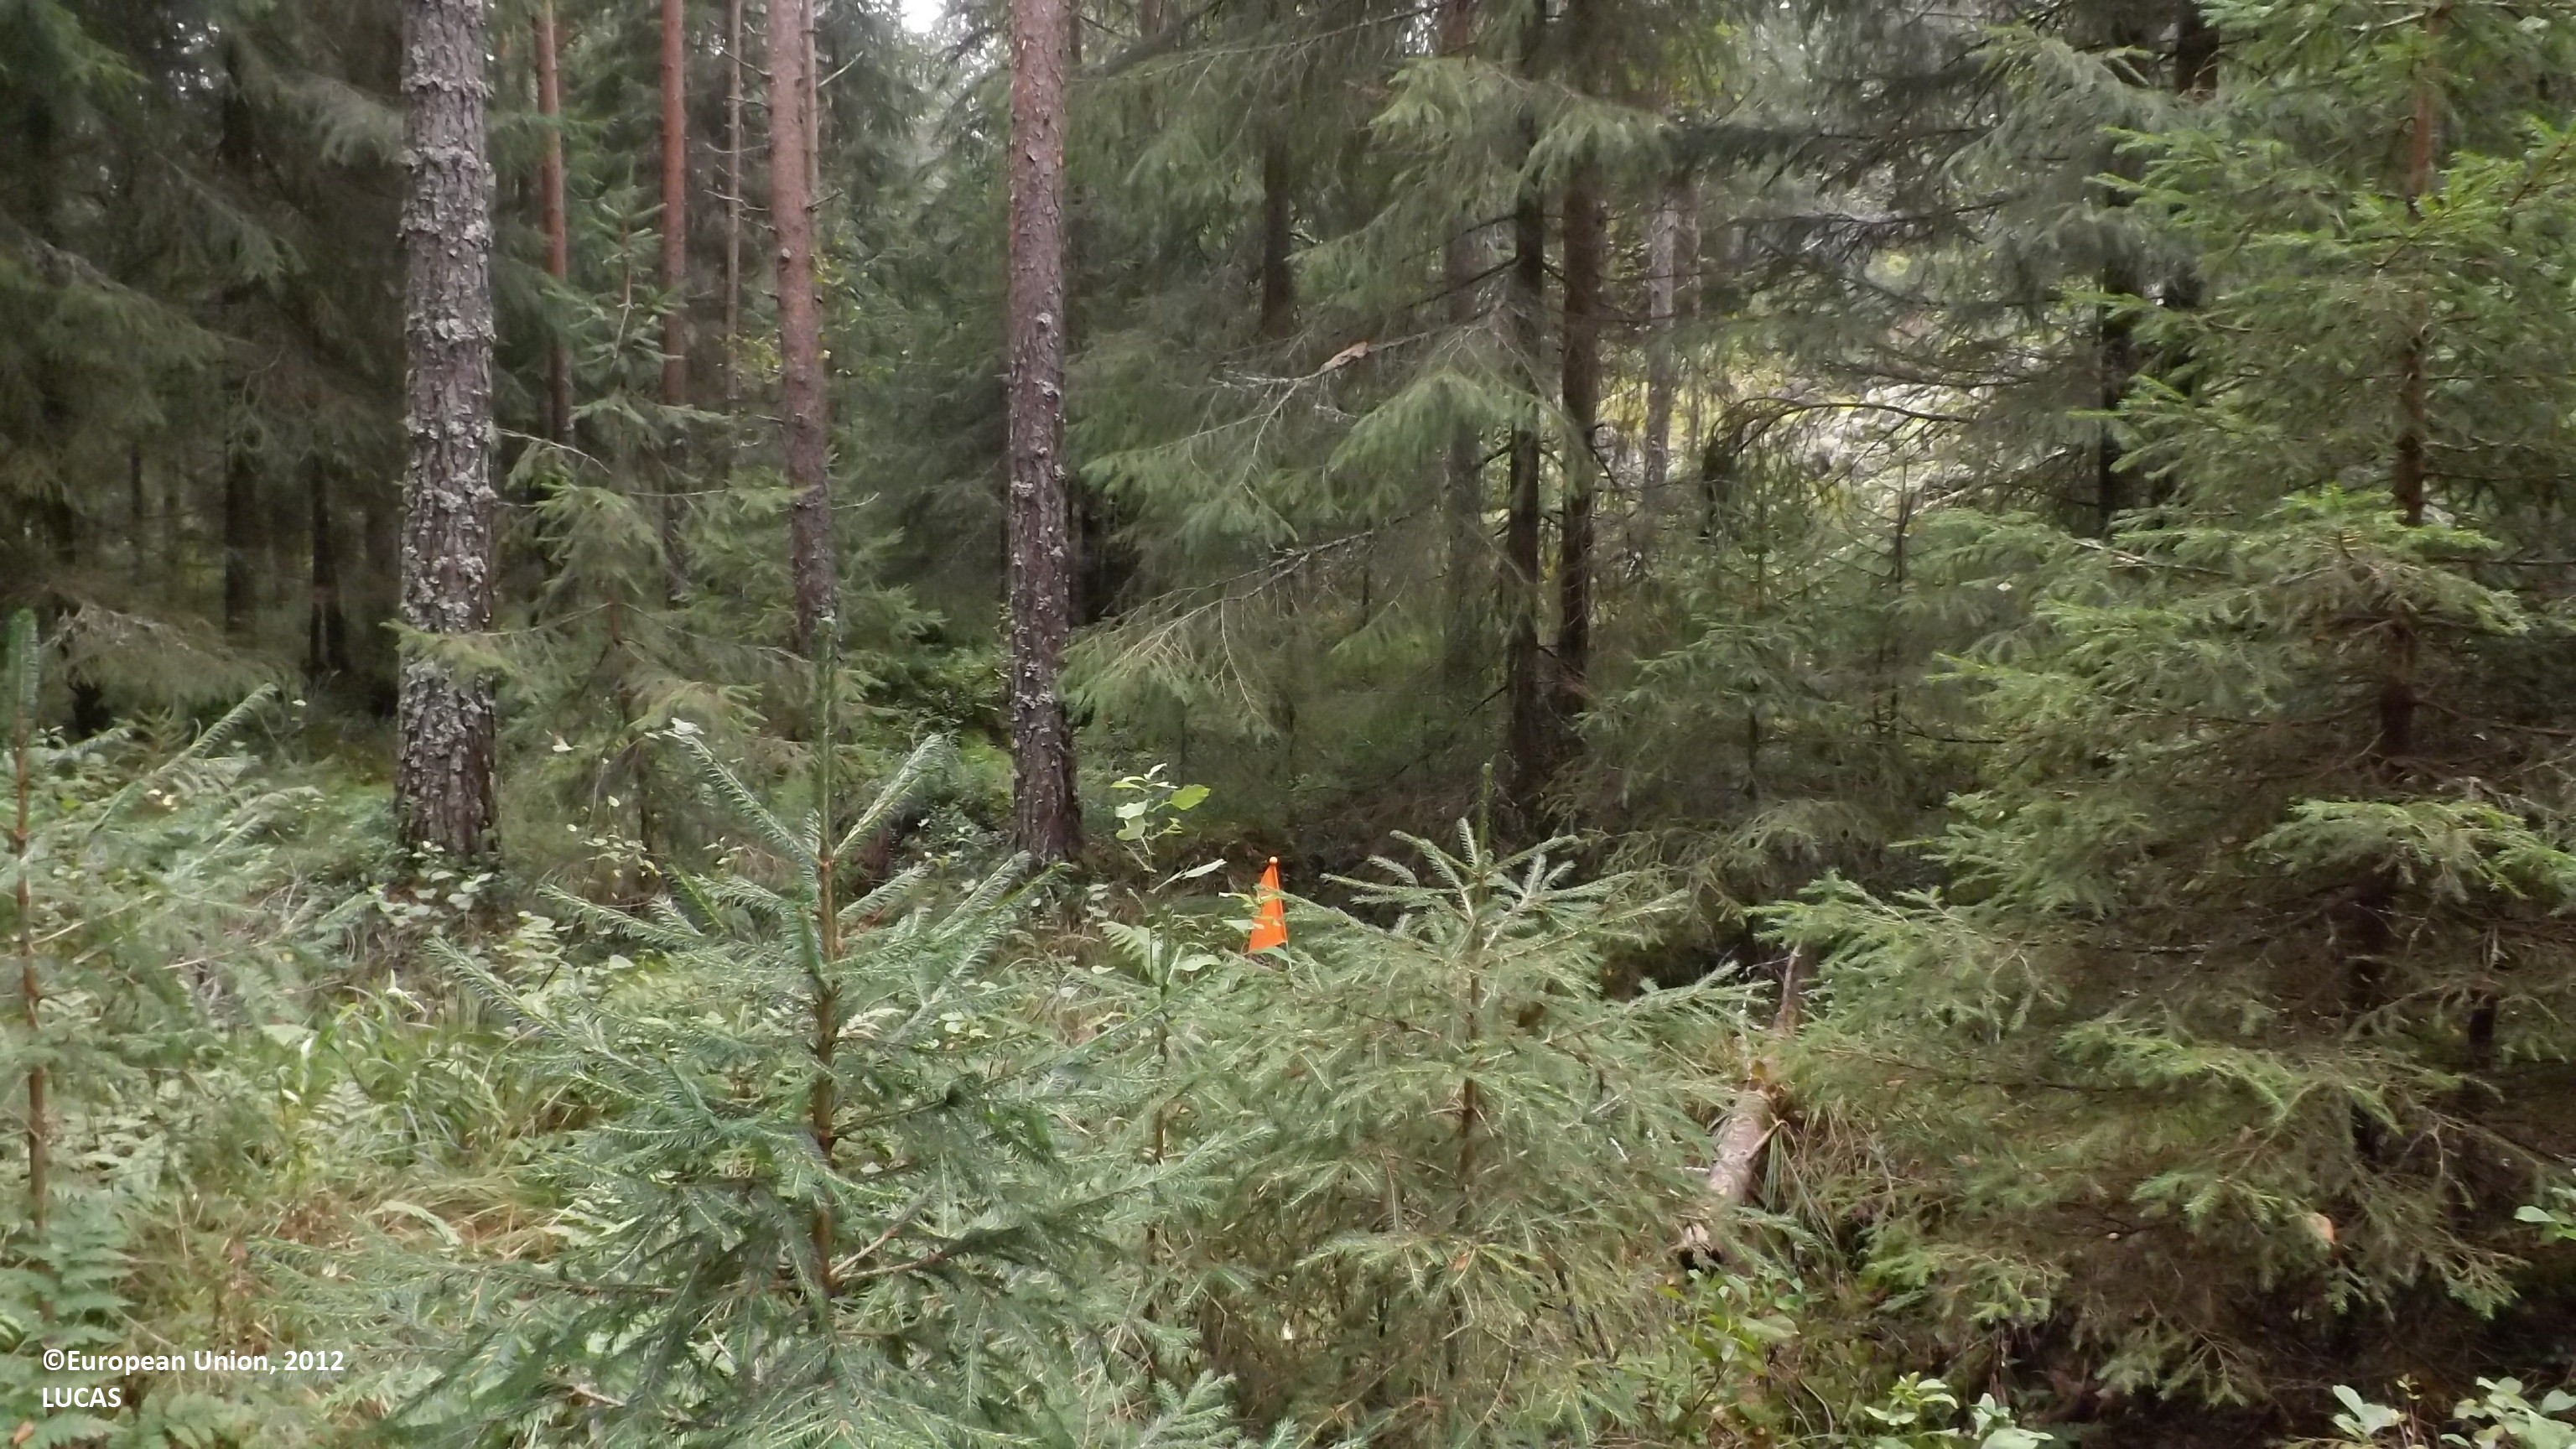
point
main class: Woodland
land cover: Other mixed woodland
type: boreal forest
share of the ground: 50 - 75 %
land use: Forestry
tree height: > 5 m
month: August
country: FI
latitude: 63.7697
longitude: 23.4220
